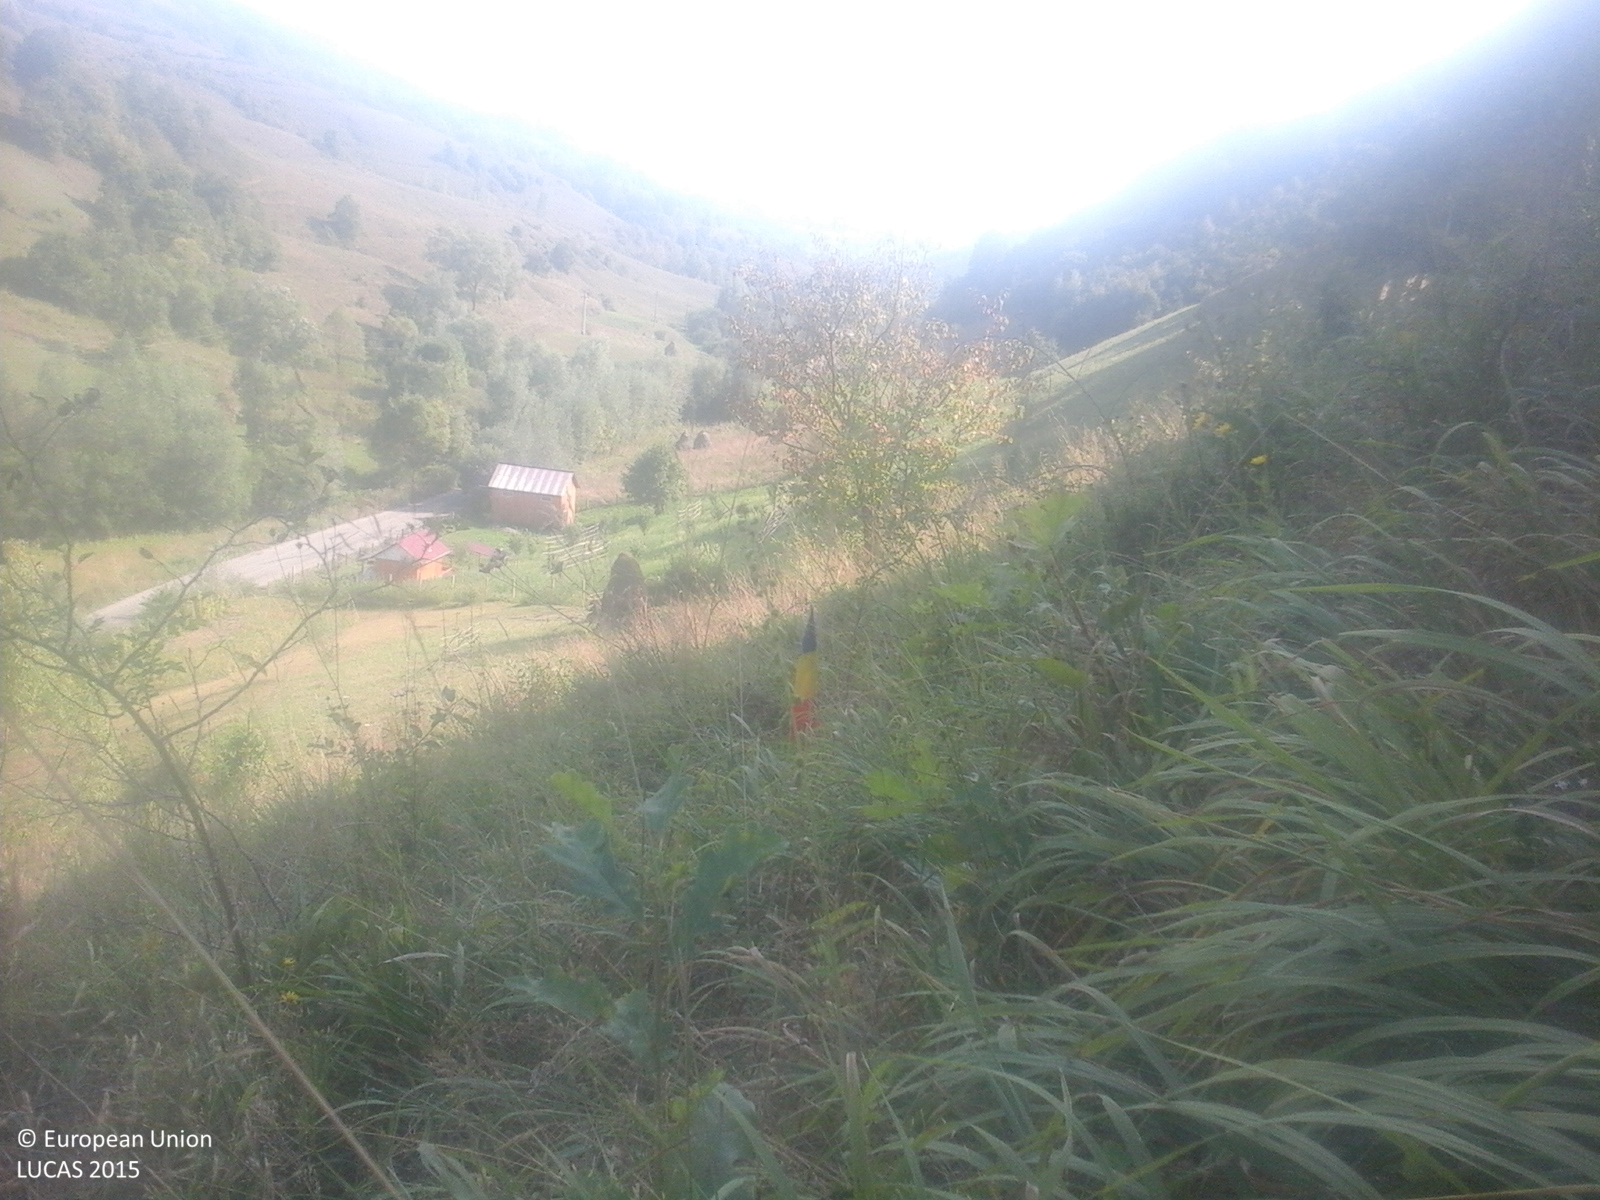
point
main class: Grassland
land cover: Grassland with sparse tree/shrub cover
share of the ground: > 75 %
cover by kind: herbaceous plants 85 %, shrubs 10 %, broadleaved forest trees 5 %
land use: Agriculture (excluding fallow land and kitchen gardens)
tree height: < 5 m
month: September
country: RO
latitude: 47.7217
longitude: 24.3154
